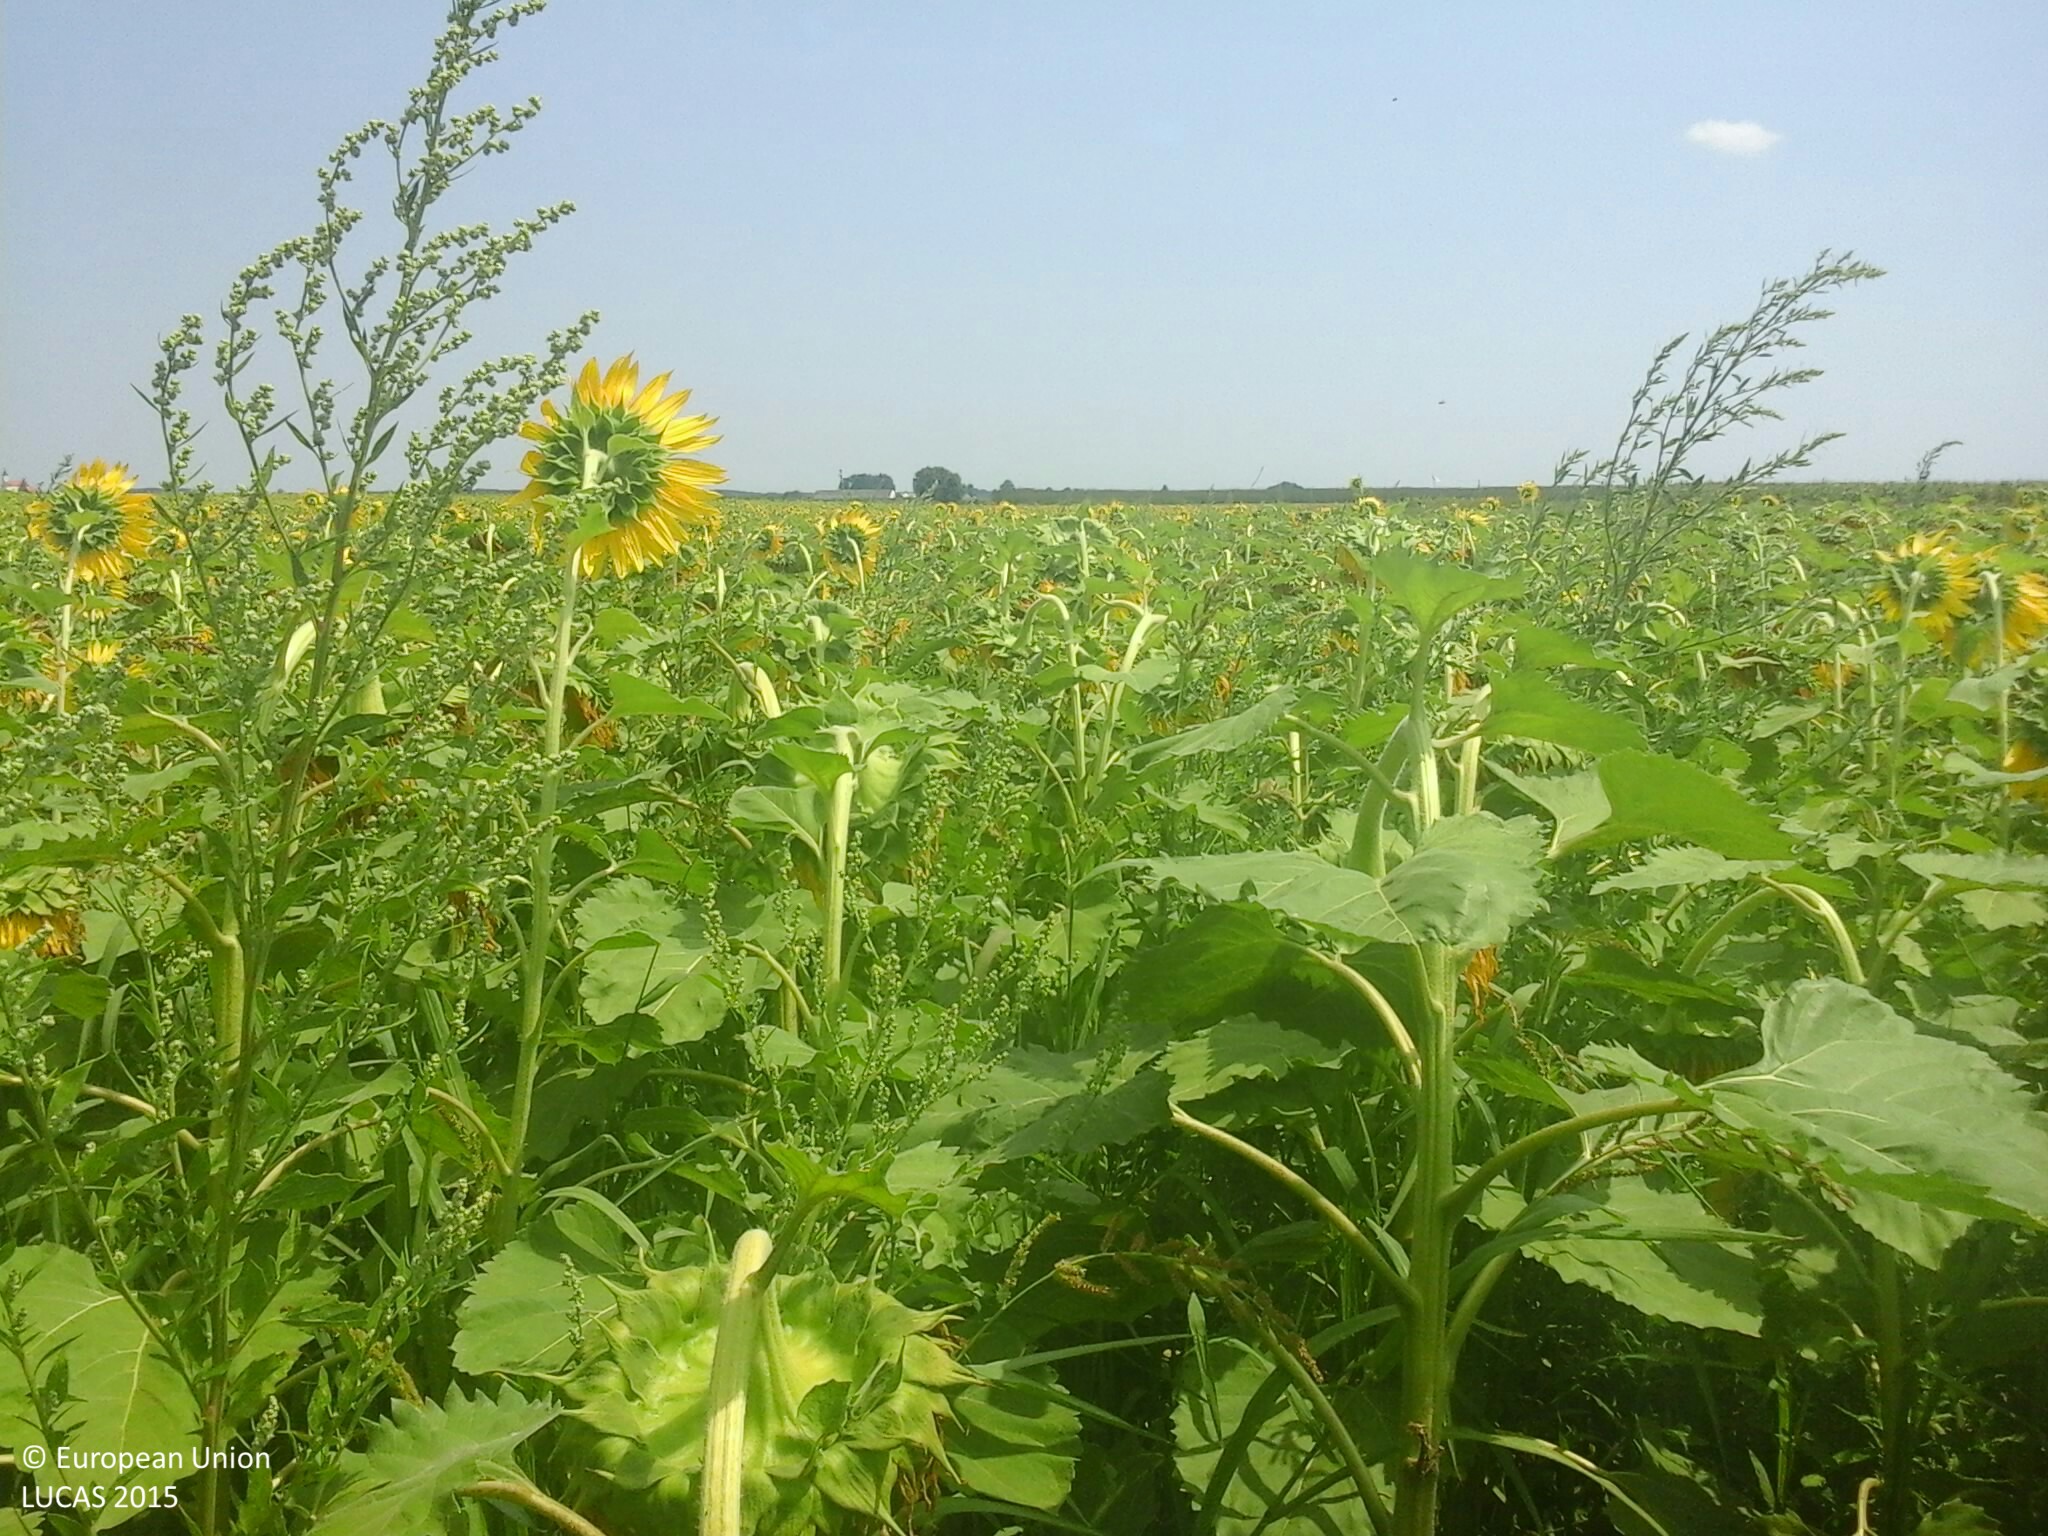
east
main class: Cropland
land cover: Sunflower
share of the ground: > 75 %
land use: Agriculture (excluding fallow land and kitchen gardens)
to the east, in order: Sunflower; Grass margins; Tracks; Grass margins; Sunflower; Grassland without tree/shrub cover
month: July
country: HU
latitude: 46.7974
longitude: 20.0992
